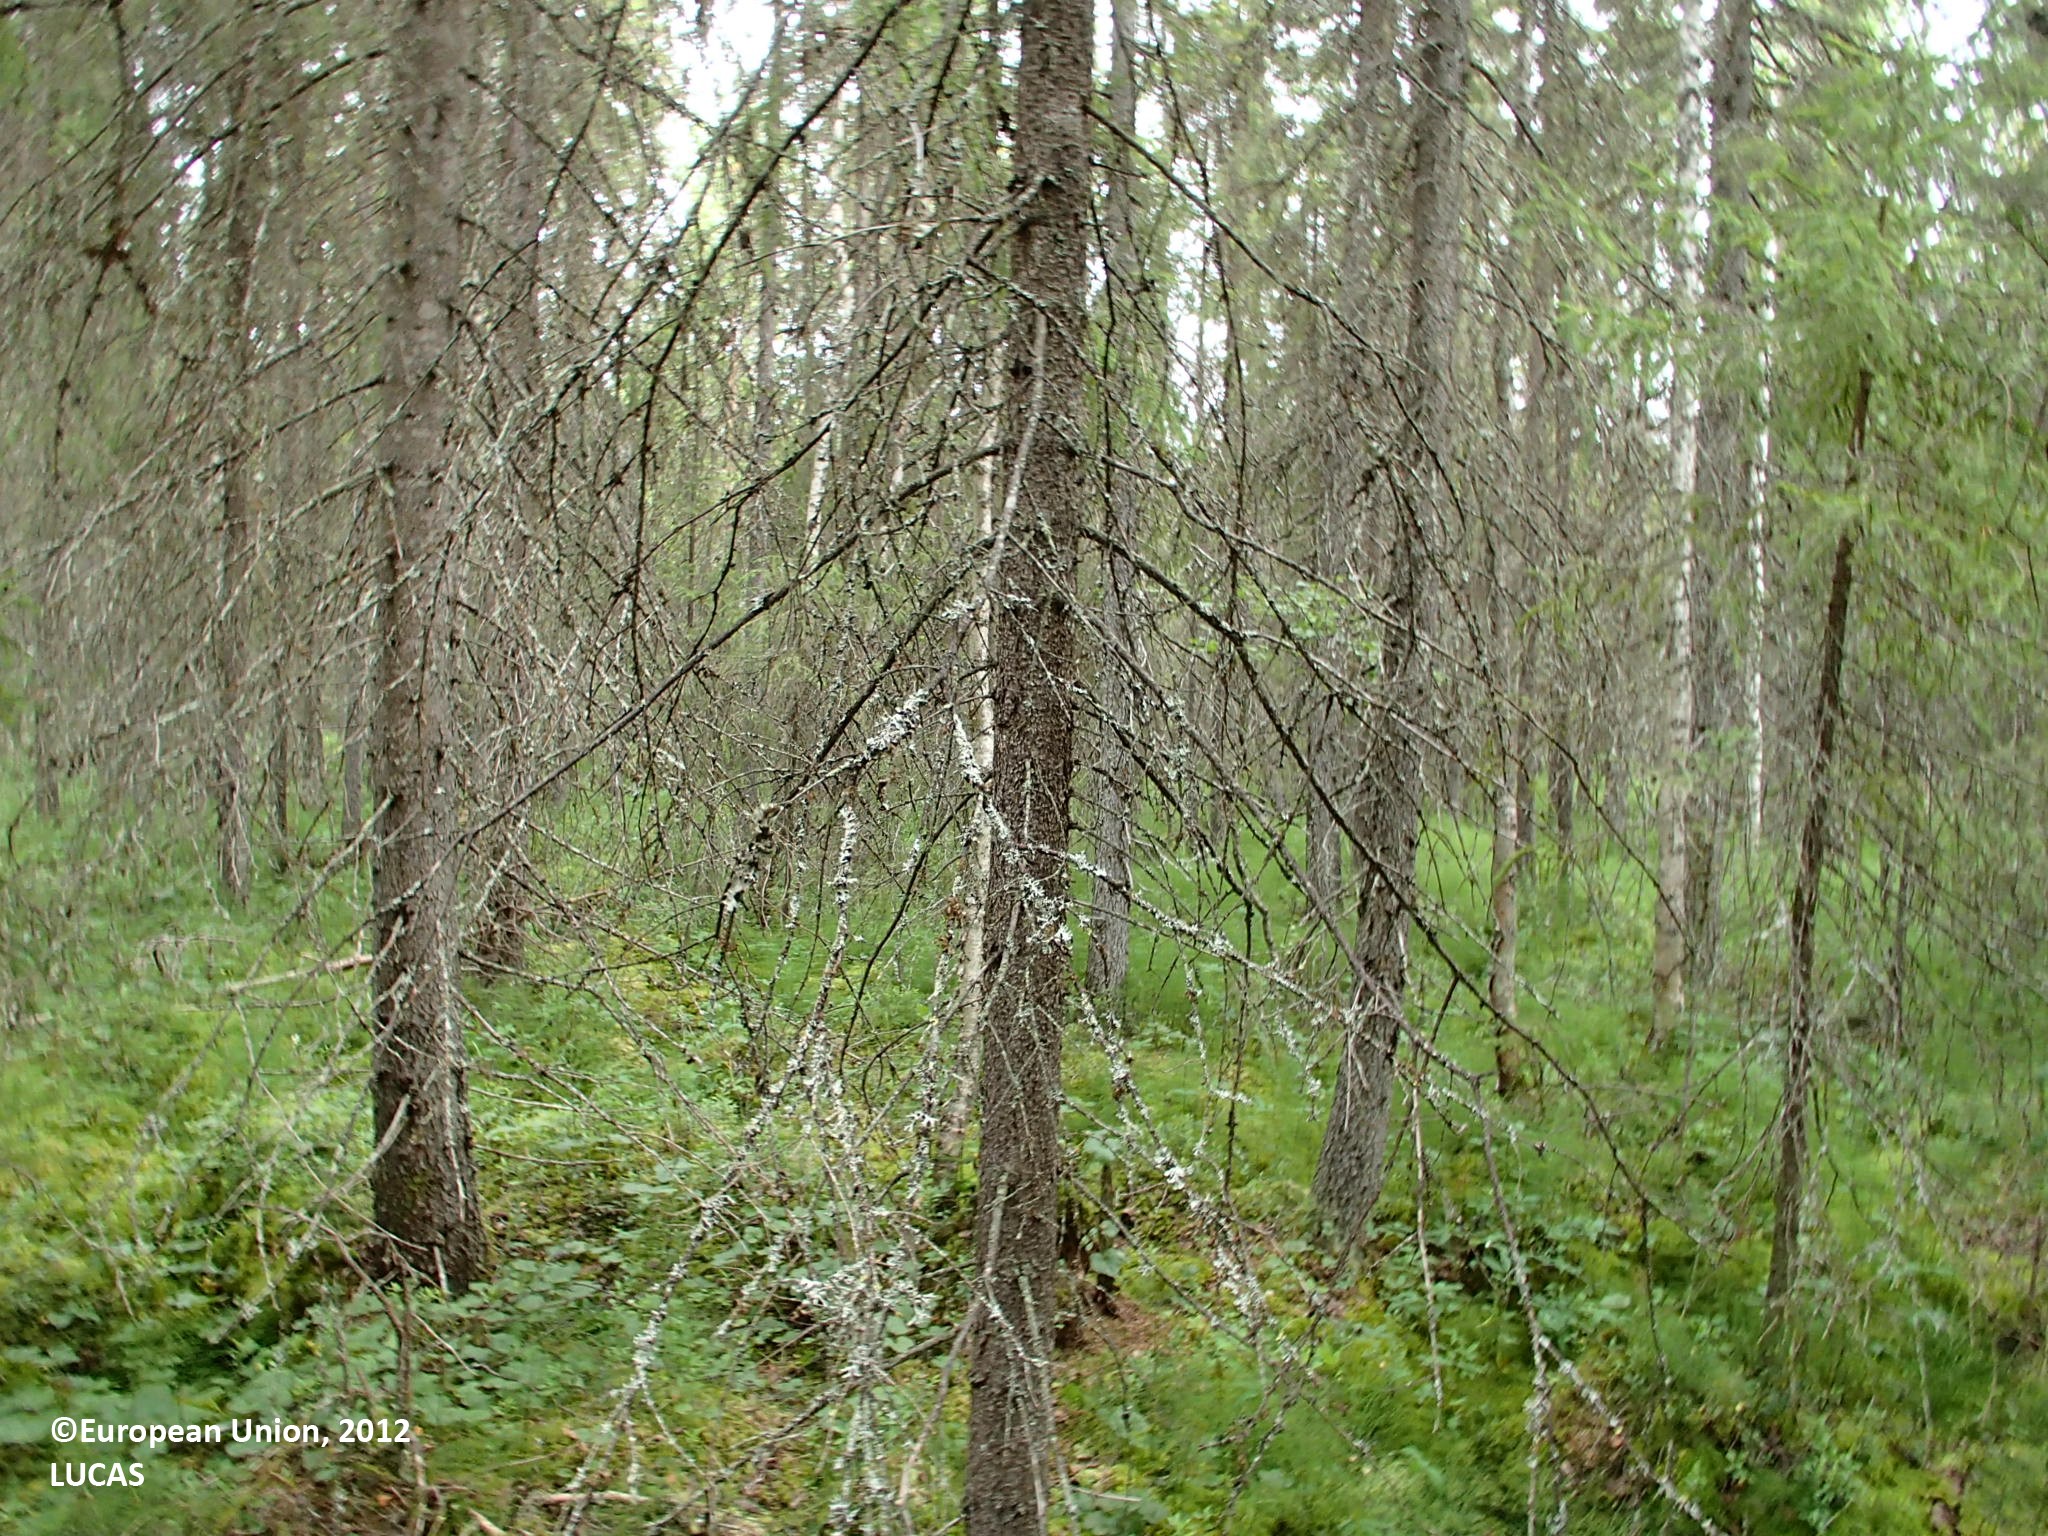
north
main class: Woodland
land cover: Other coniferous woodland
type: boreal forest
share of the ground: > 75 %
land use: Forestry
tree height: > 5 m
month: July
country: FI
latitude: 66.4151
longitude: 25.4056
